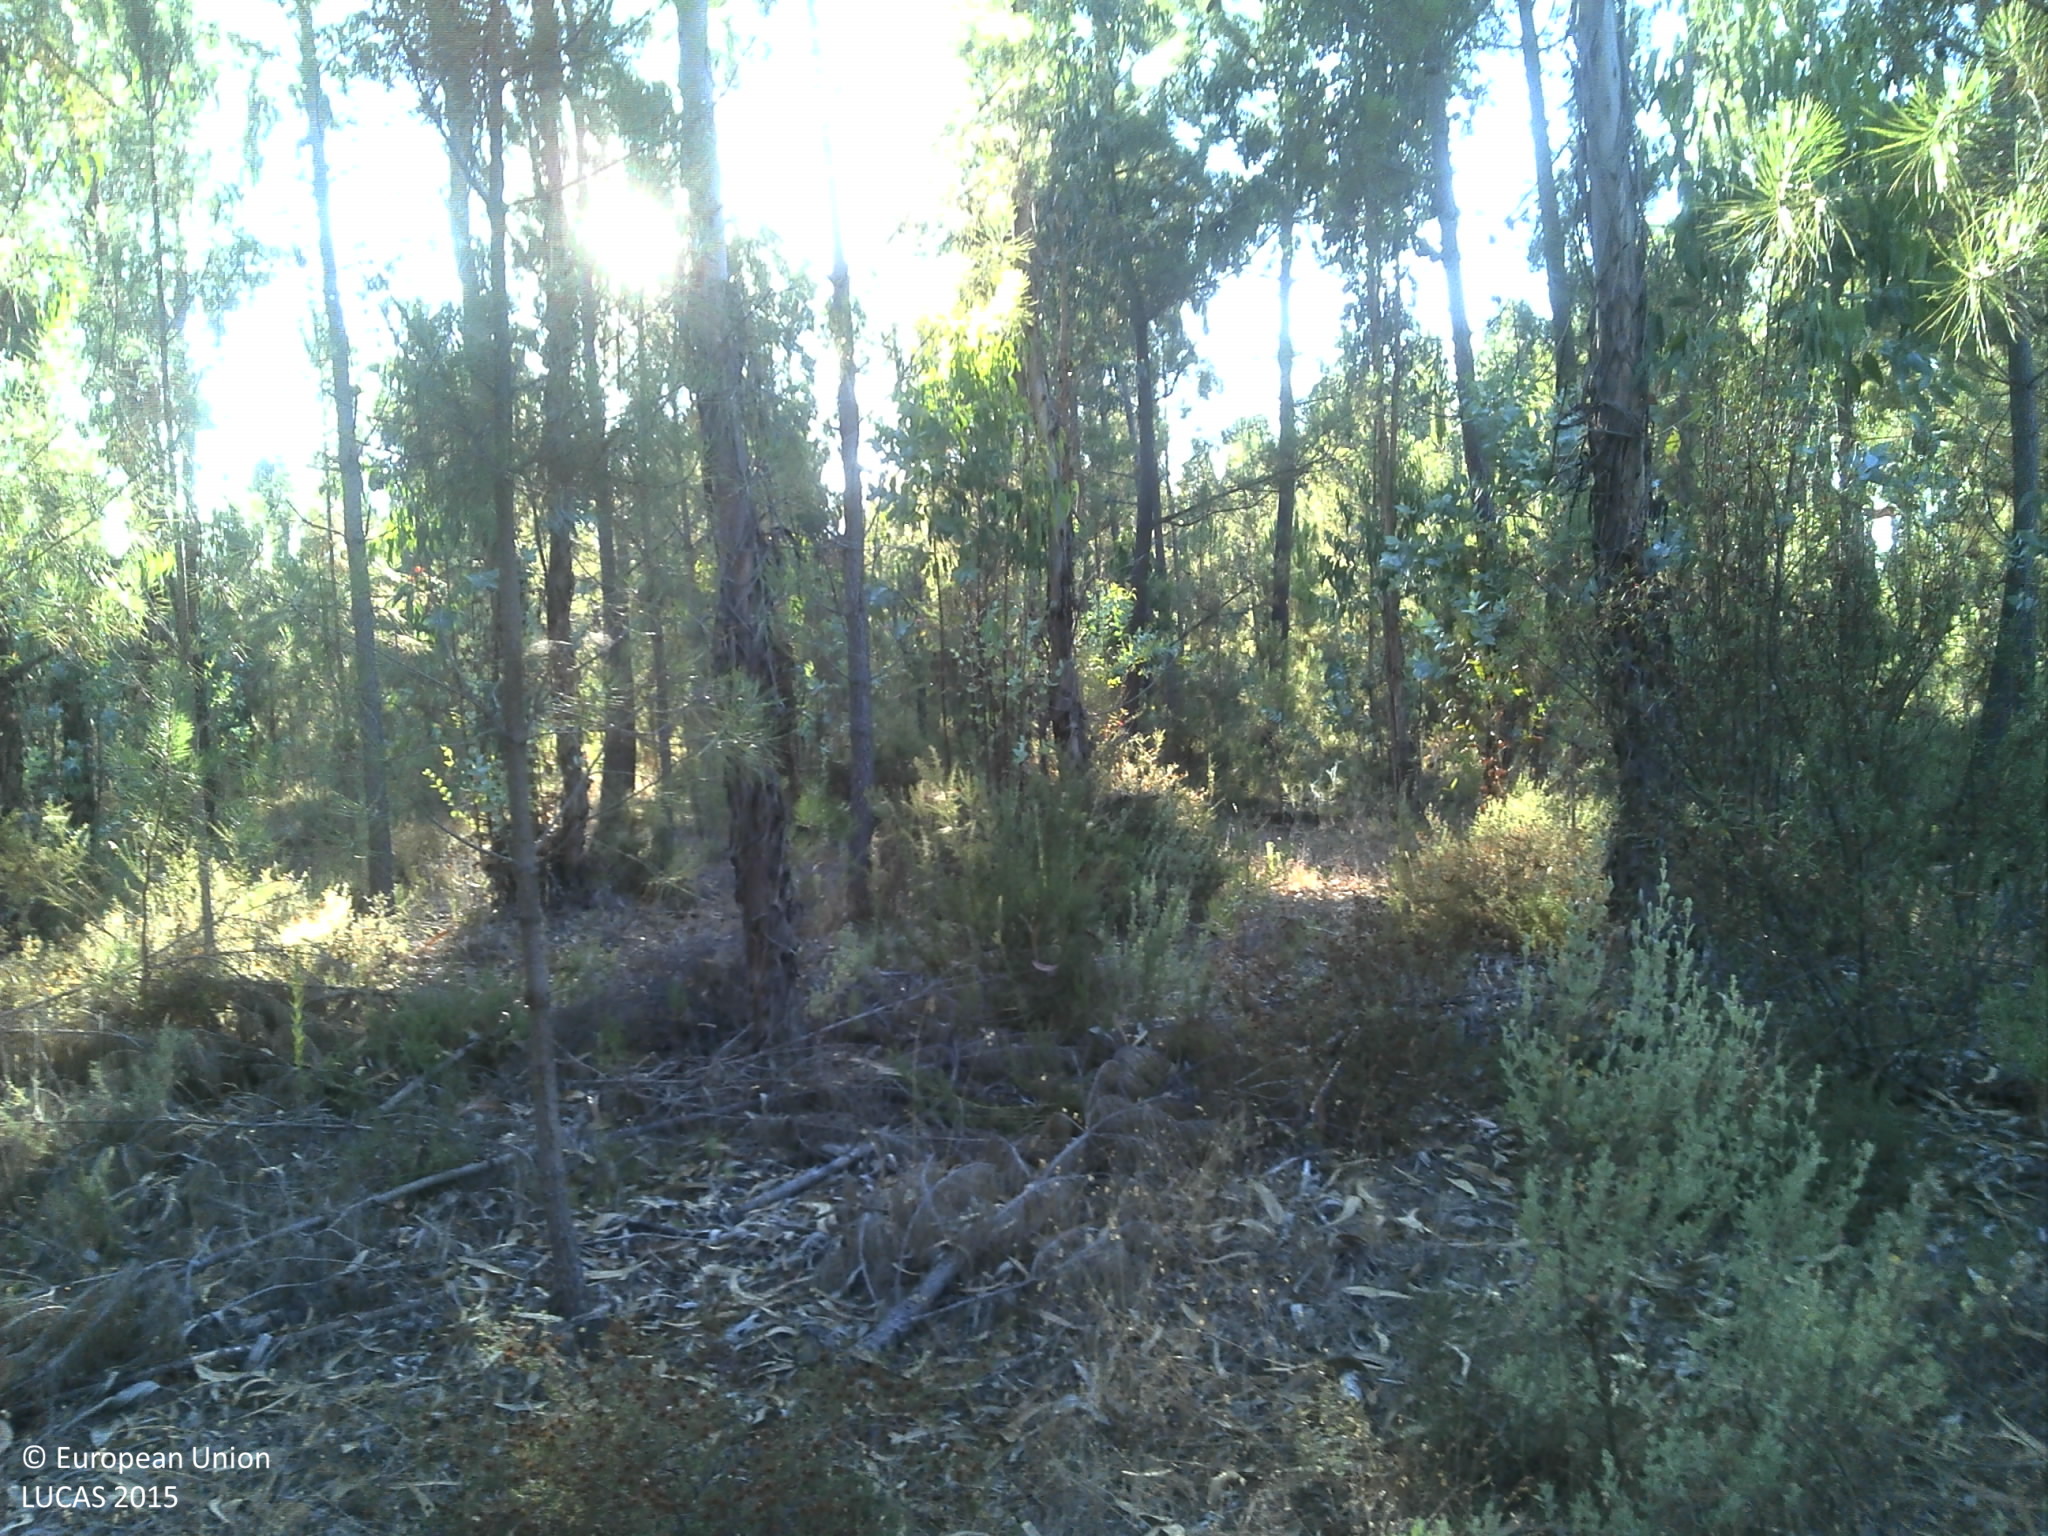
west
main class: Woodland
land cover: Pine dominated mixed woodland
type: coniferous forest of the mediterranean region
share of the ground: 25 - 50 %
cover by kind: coniferous forest trees 45 %, broadleaved forest trees 30 %, herbaceous plants 10 %, unconsolidated bare surface 10 %, shrubs 5 %
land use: Forestry
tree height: > 5 m
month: July
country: PT
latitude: 39.0075
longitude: -8.6952
